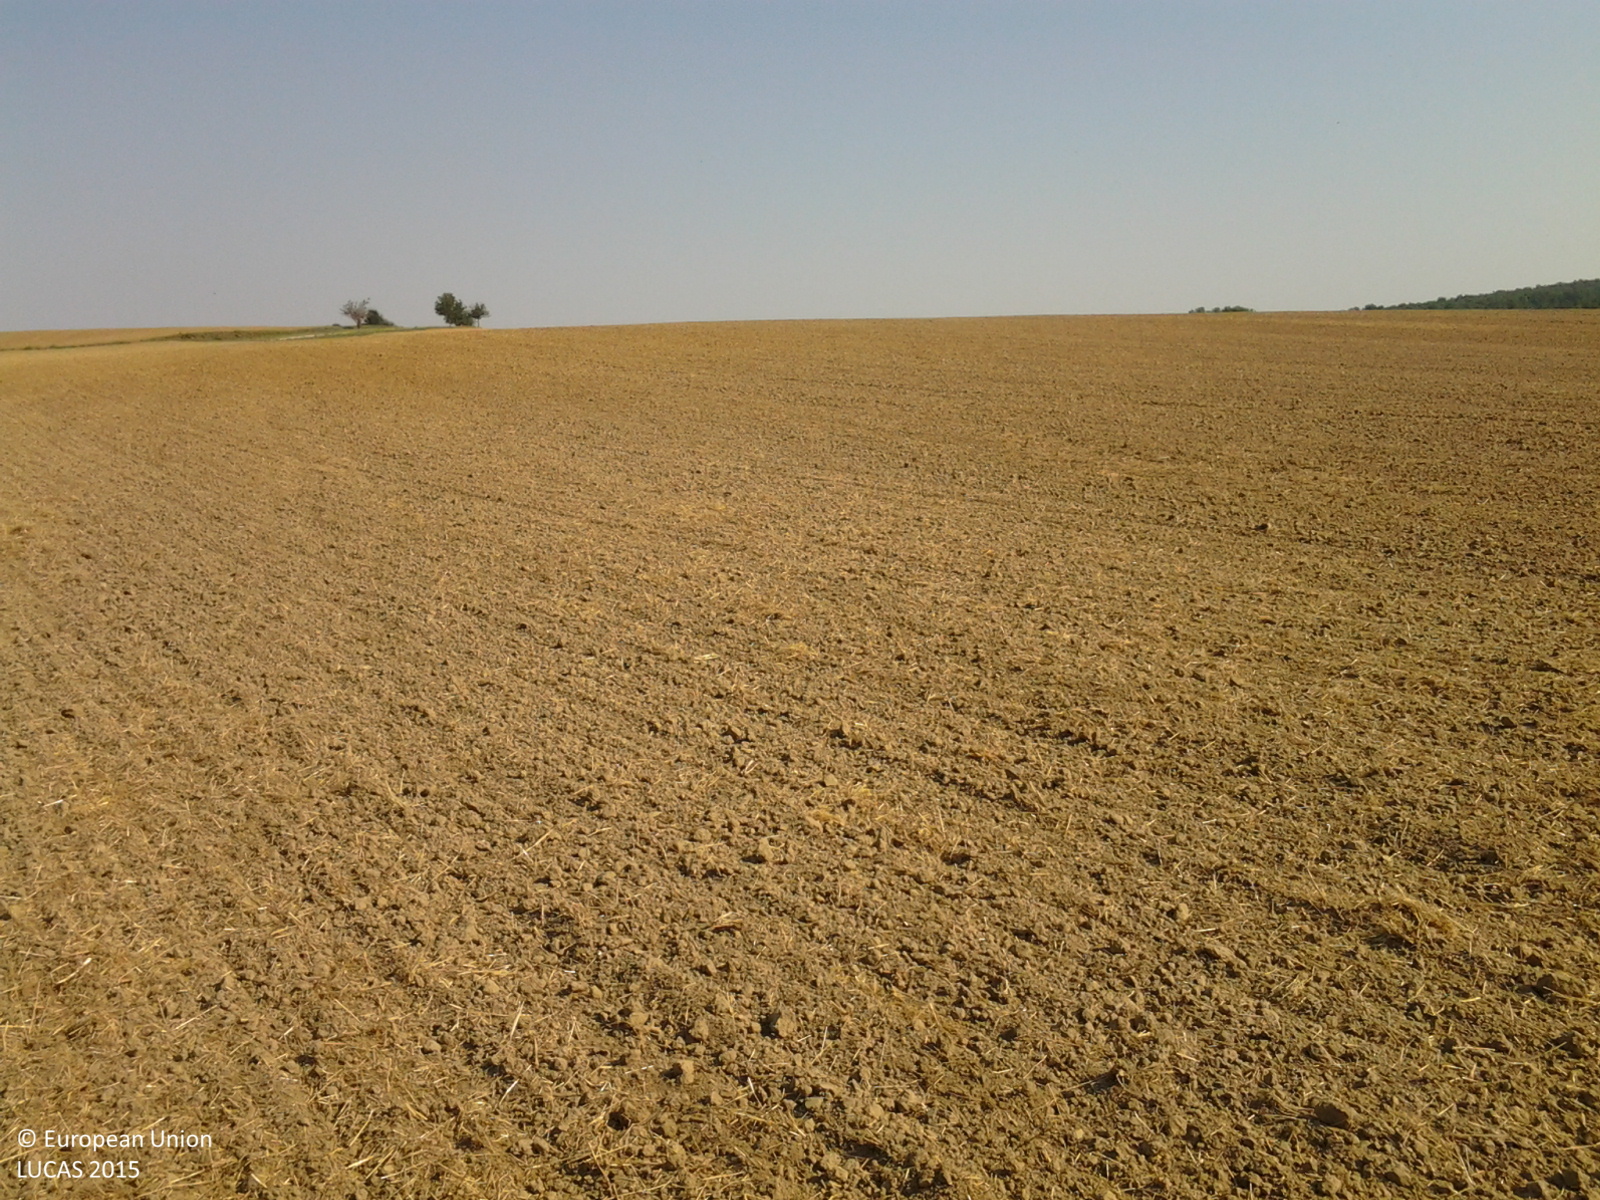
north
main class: Cropland
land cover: Oats
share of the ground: < 10 %
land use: Agriculture (excluding fallow land and kitchen gardens)
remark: Harvested field
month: August
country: HU
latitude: 46.6054
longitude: 17.0664
